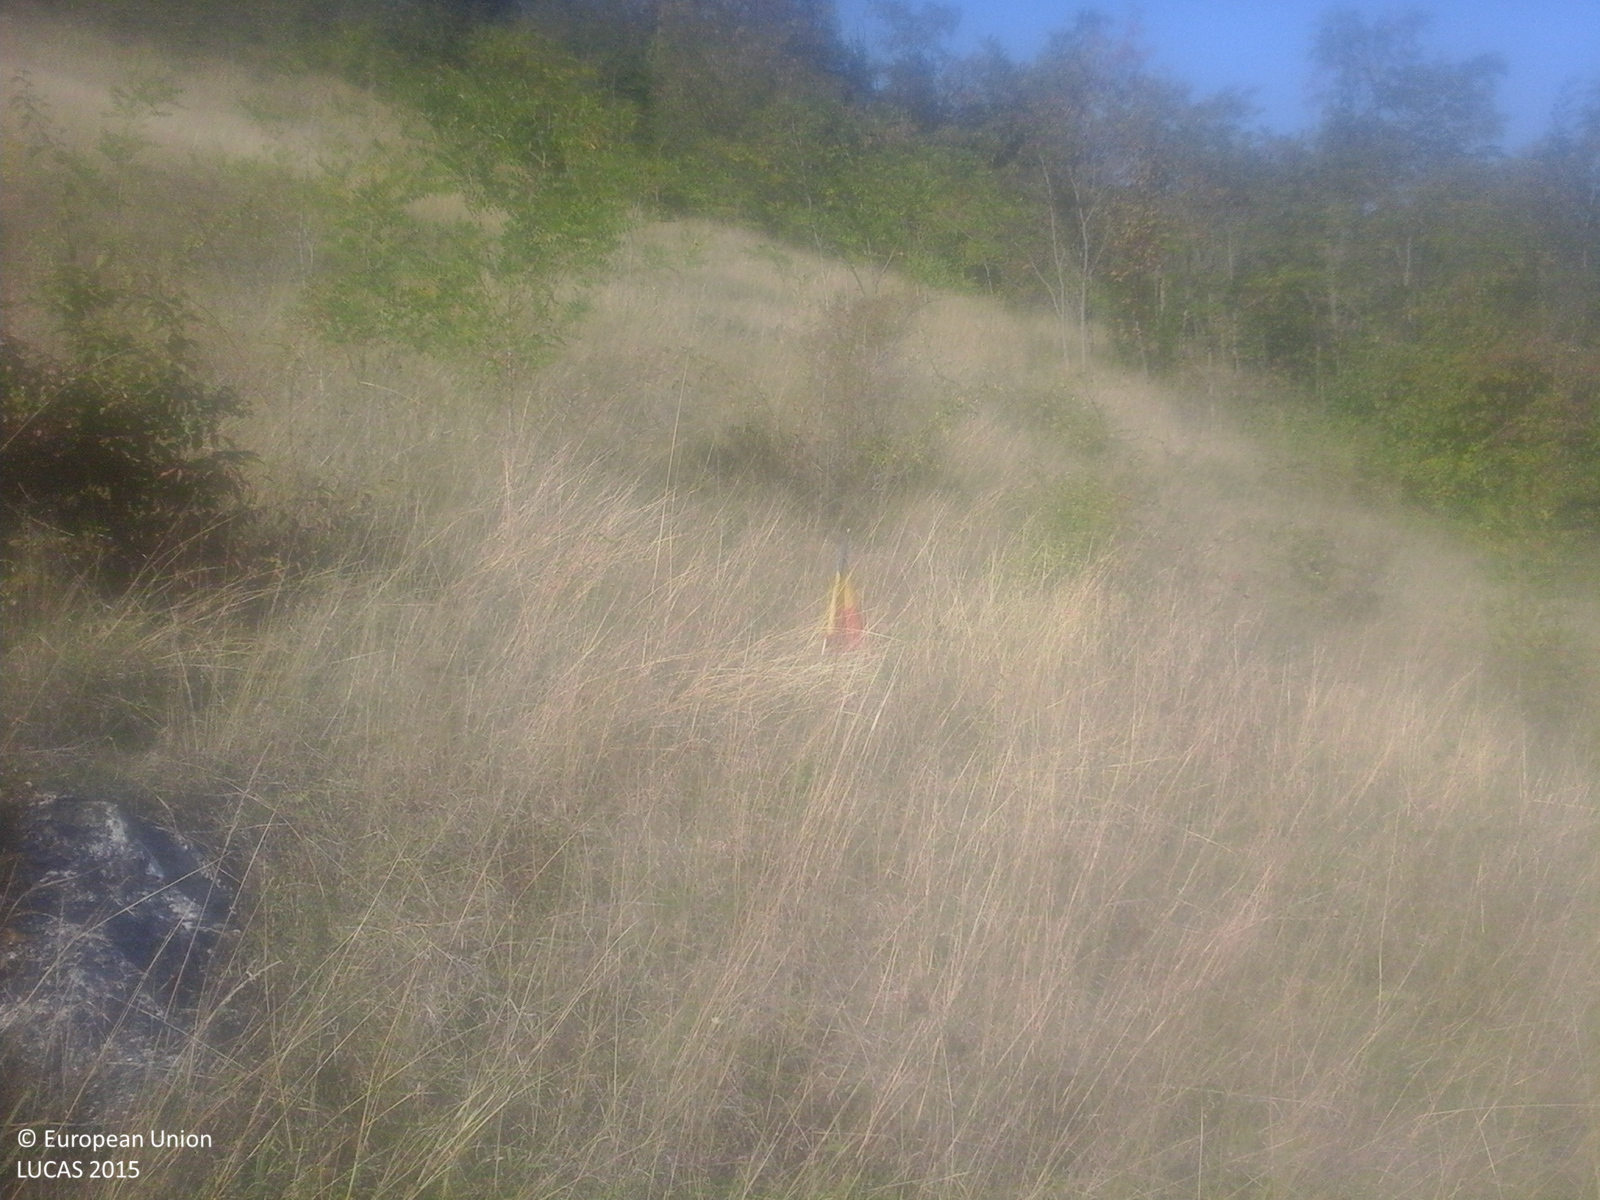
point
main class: Grassland
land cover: Grassland with sparse tree/shrub cover
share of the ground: > 75 %
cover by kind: herbaceous plants 85 %, shrubs 10 %, broadleaved forest trees 5 %
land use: Agriculture (excluding fallow land and kitchen gardens)
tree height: < 5 m
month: October
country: RO
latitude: 46.4603
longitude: 23.6243
